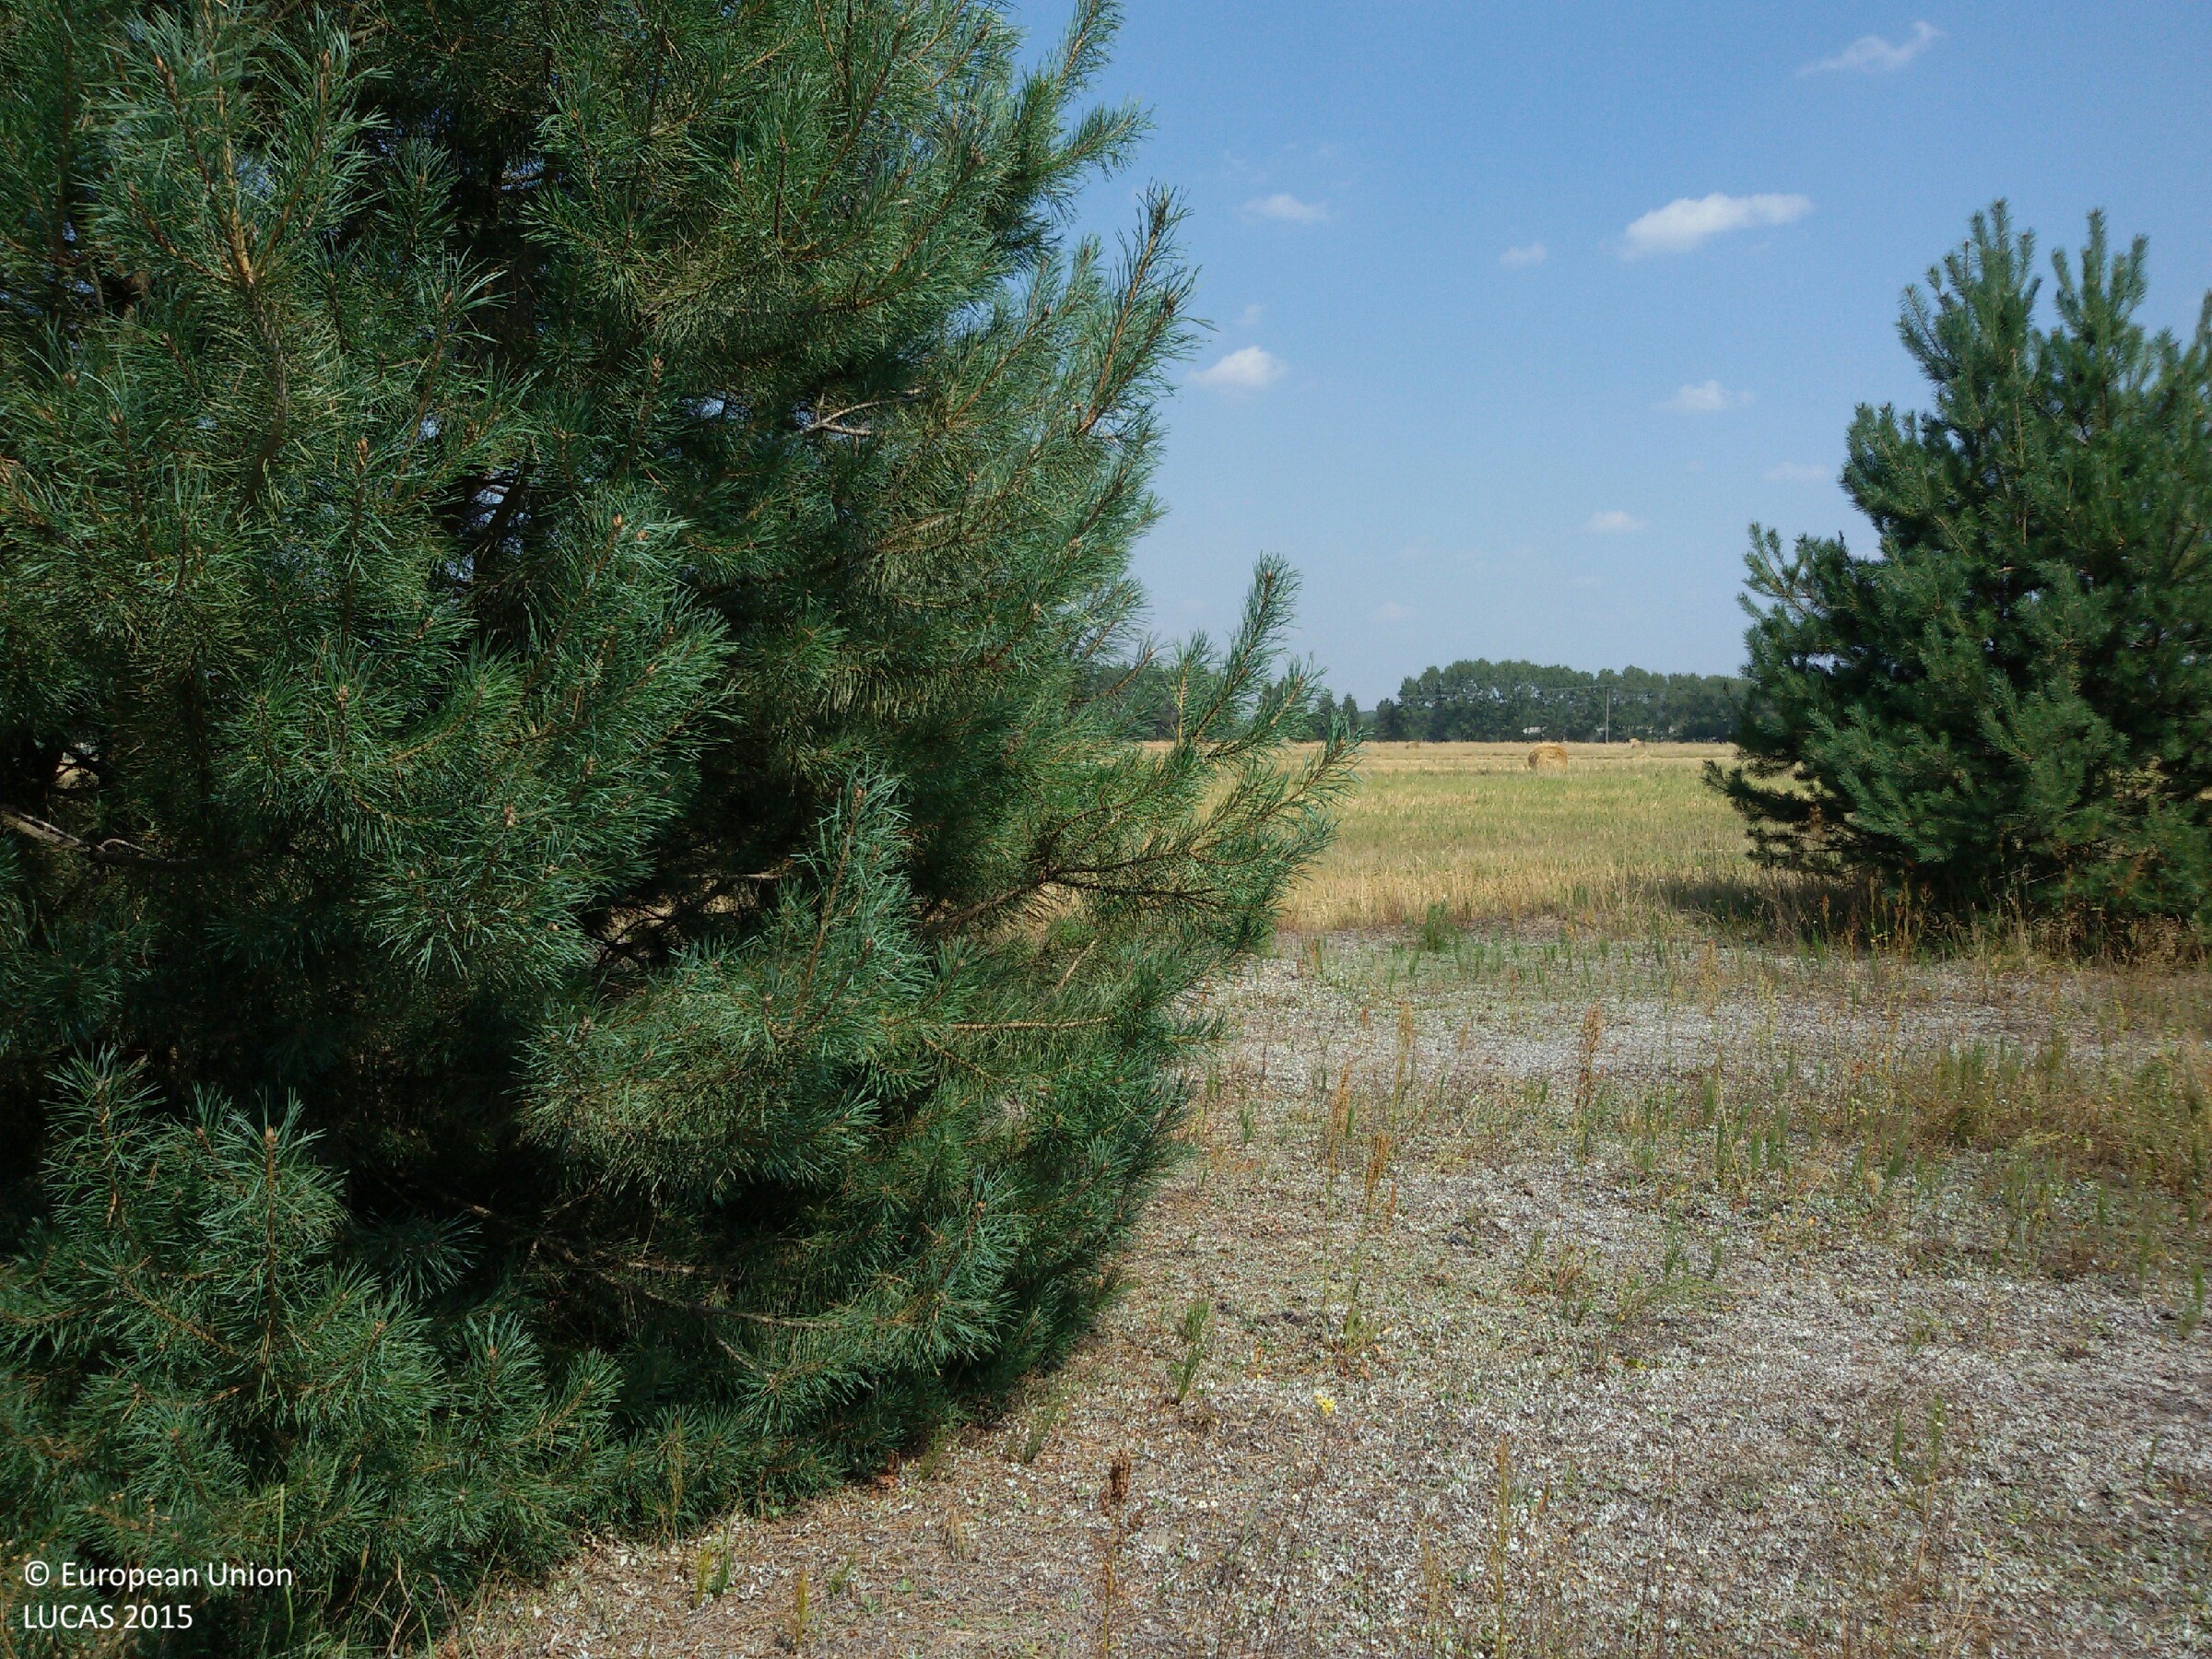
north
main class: Woodland
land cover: Pine dominated coniferous woodland
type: hemiboreal forest and nemoral coniferous forest and mixed broadleaved-coniferous forest
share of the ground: 25 - 50 %
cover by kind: herbaceous plants 45 %, coniferous forest trees 40 %, unconsolidated bare surface 10 %, lichens and mosses 5 %
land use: Abandoned areas
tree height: > 5 m
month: August
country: PL
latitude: 51.6410
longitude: 22.8317
